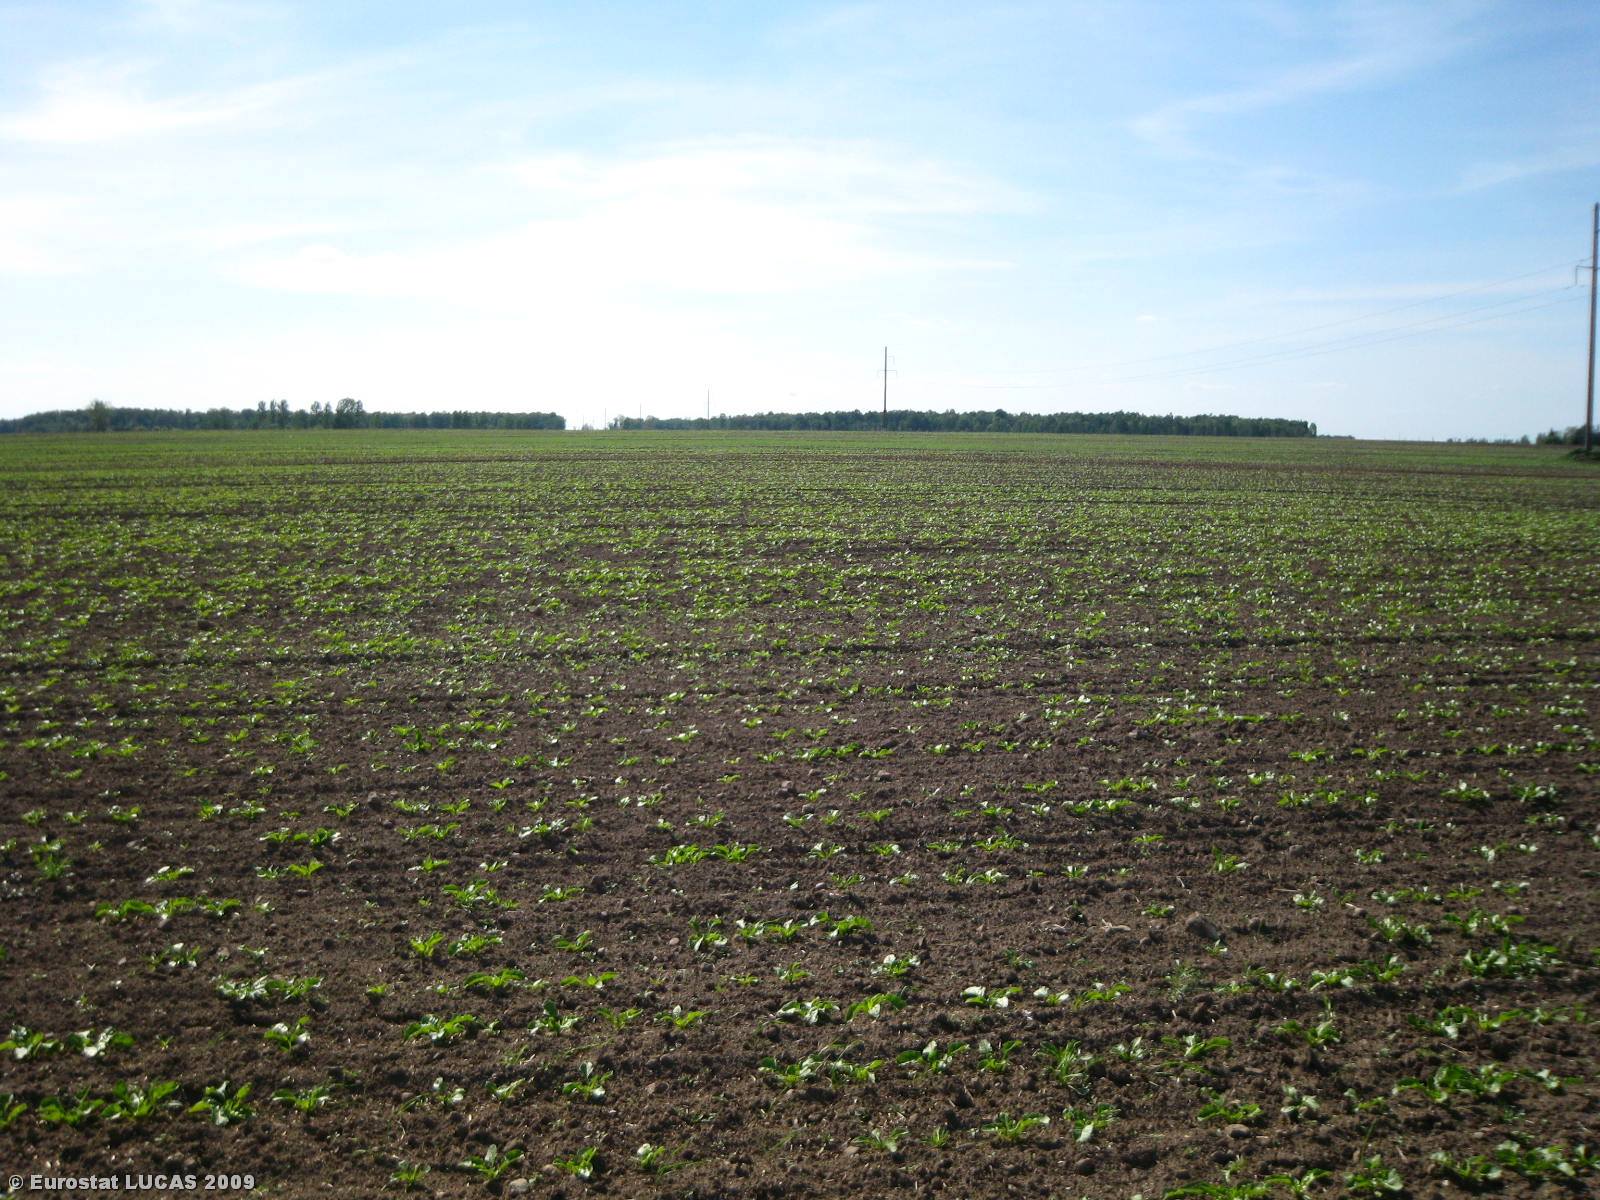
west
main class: Cropland
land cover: Sugar beet
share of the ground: 50 - 75 %
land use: Agriculture (excluding fallow land and kitchen gardens)
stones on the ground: < 10 %
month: May
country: LT
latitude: 55.7305
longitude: 23.9572
